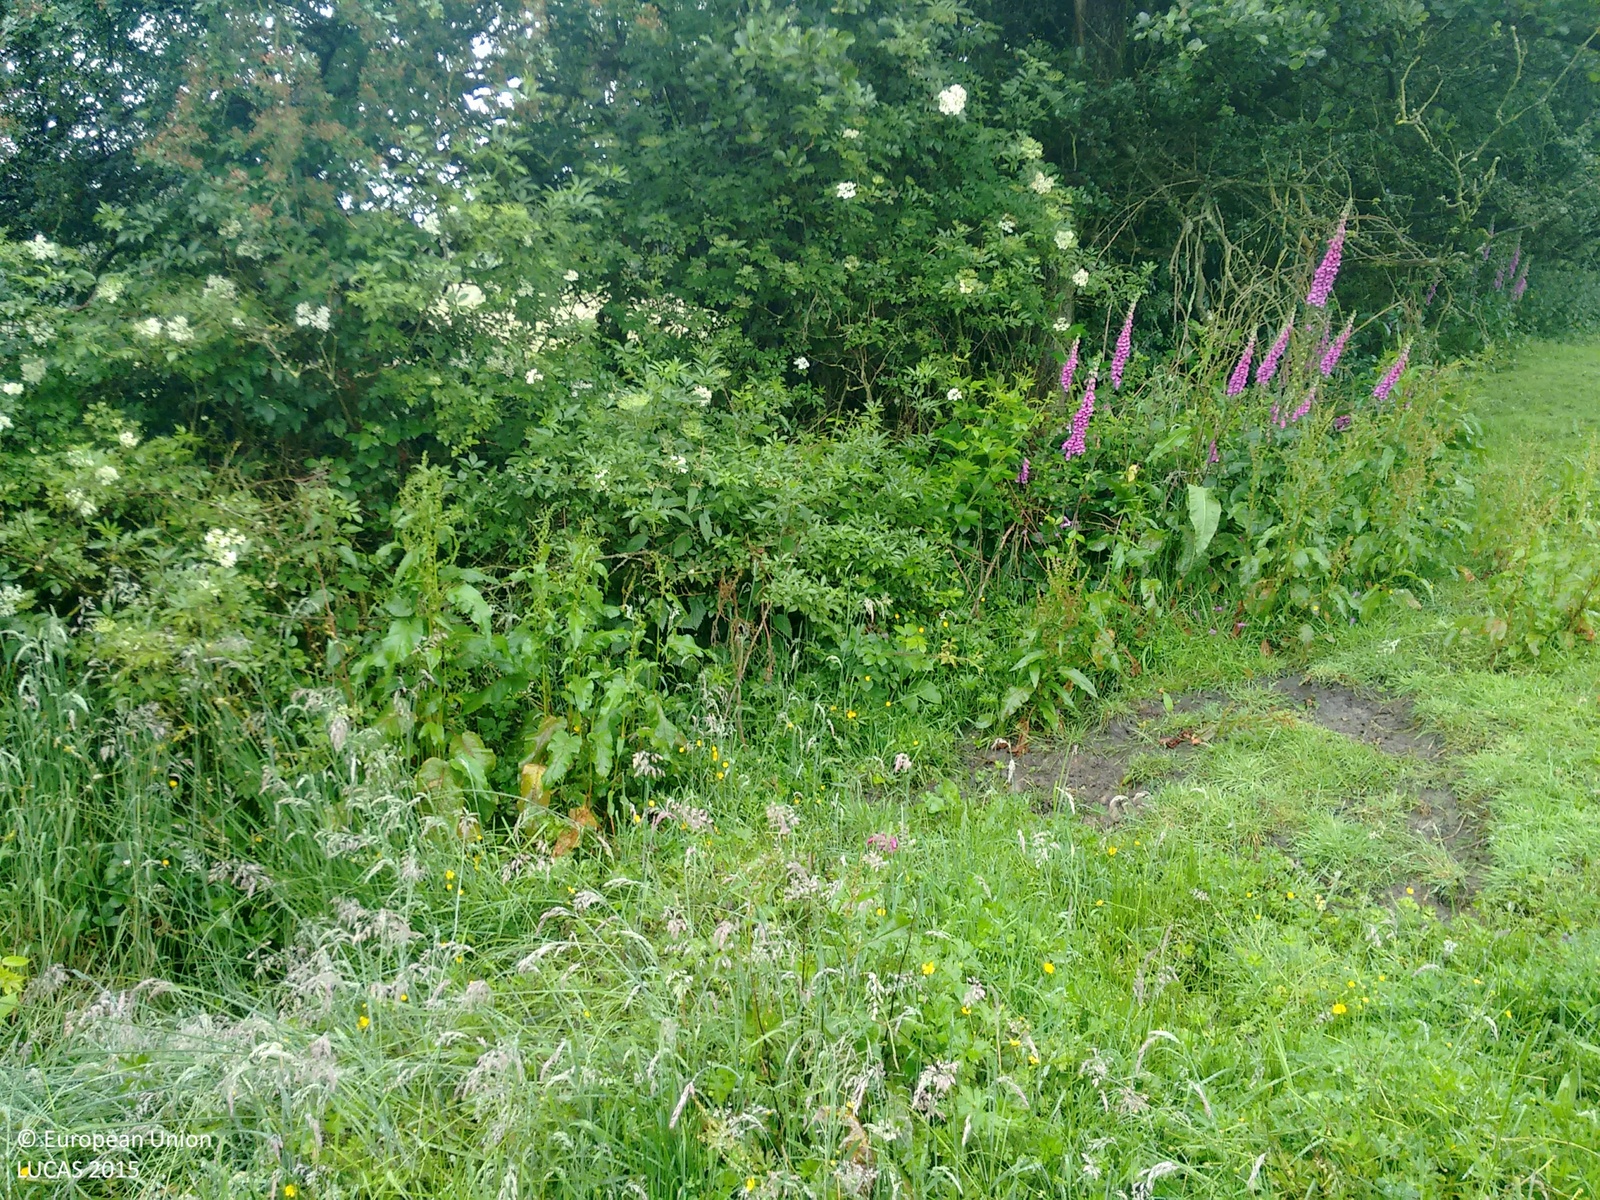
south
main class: Grassland
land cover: Grassland without tree/shrub cover
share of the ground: > 75 %
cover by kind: herbaceous plants 100 %
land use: Agriculture (excluding fallow land and kitchen gardens)
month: July
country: GB
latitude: 53.1447
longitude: -2.0338
